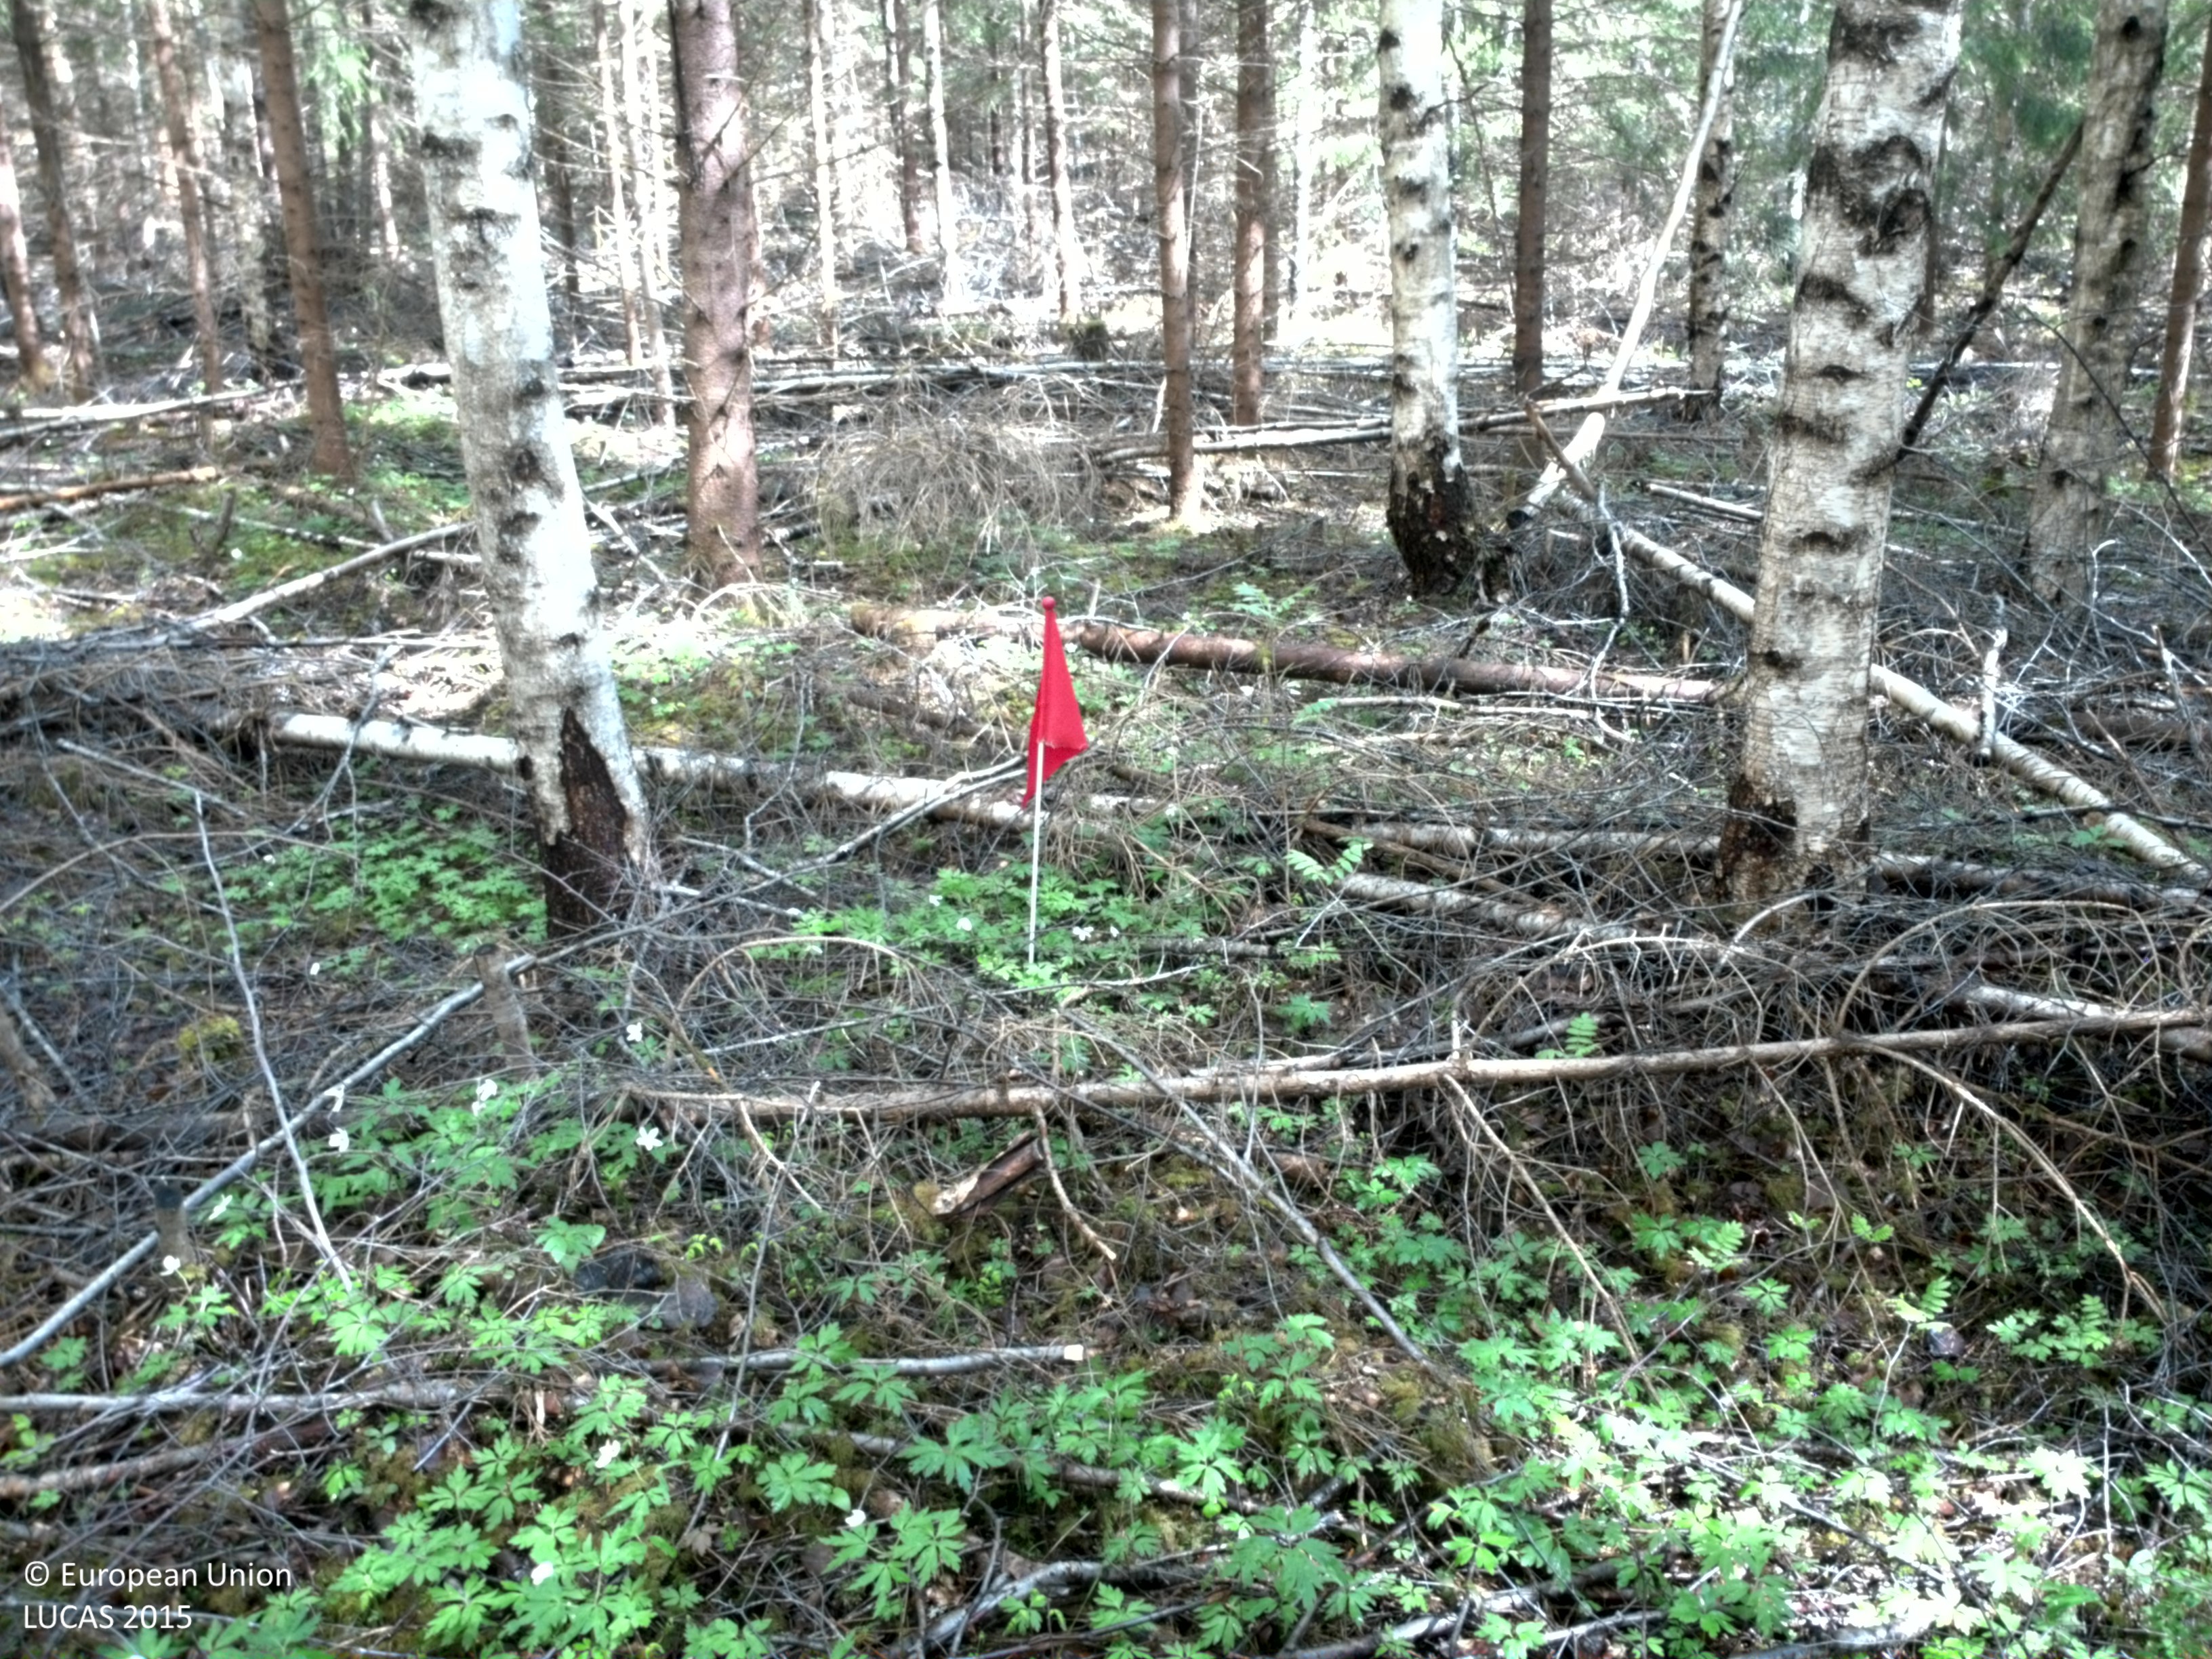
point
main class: Woodland
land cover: Broadleaved woodland
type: boreal forest
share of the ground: > 75 %
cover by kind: broadleaved forest trees 95 %, coniferous forest trees 5 %
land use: Forestry
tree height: > 5 m
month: May
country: SE
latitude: 59.5297
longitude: 12.4159
